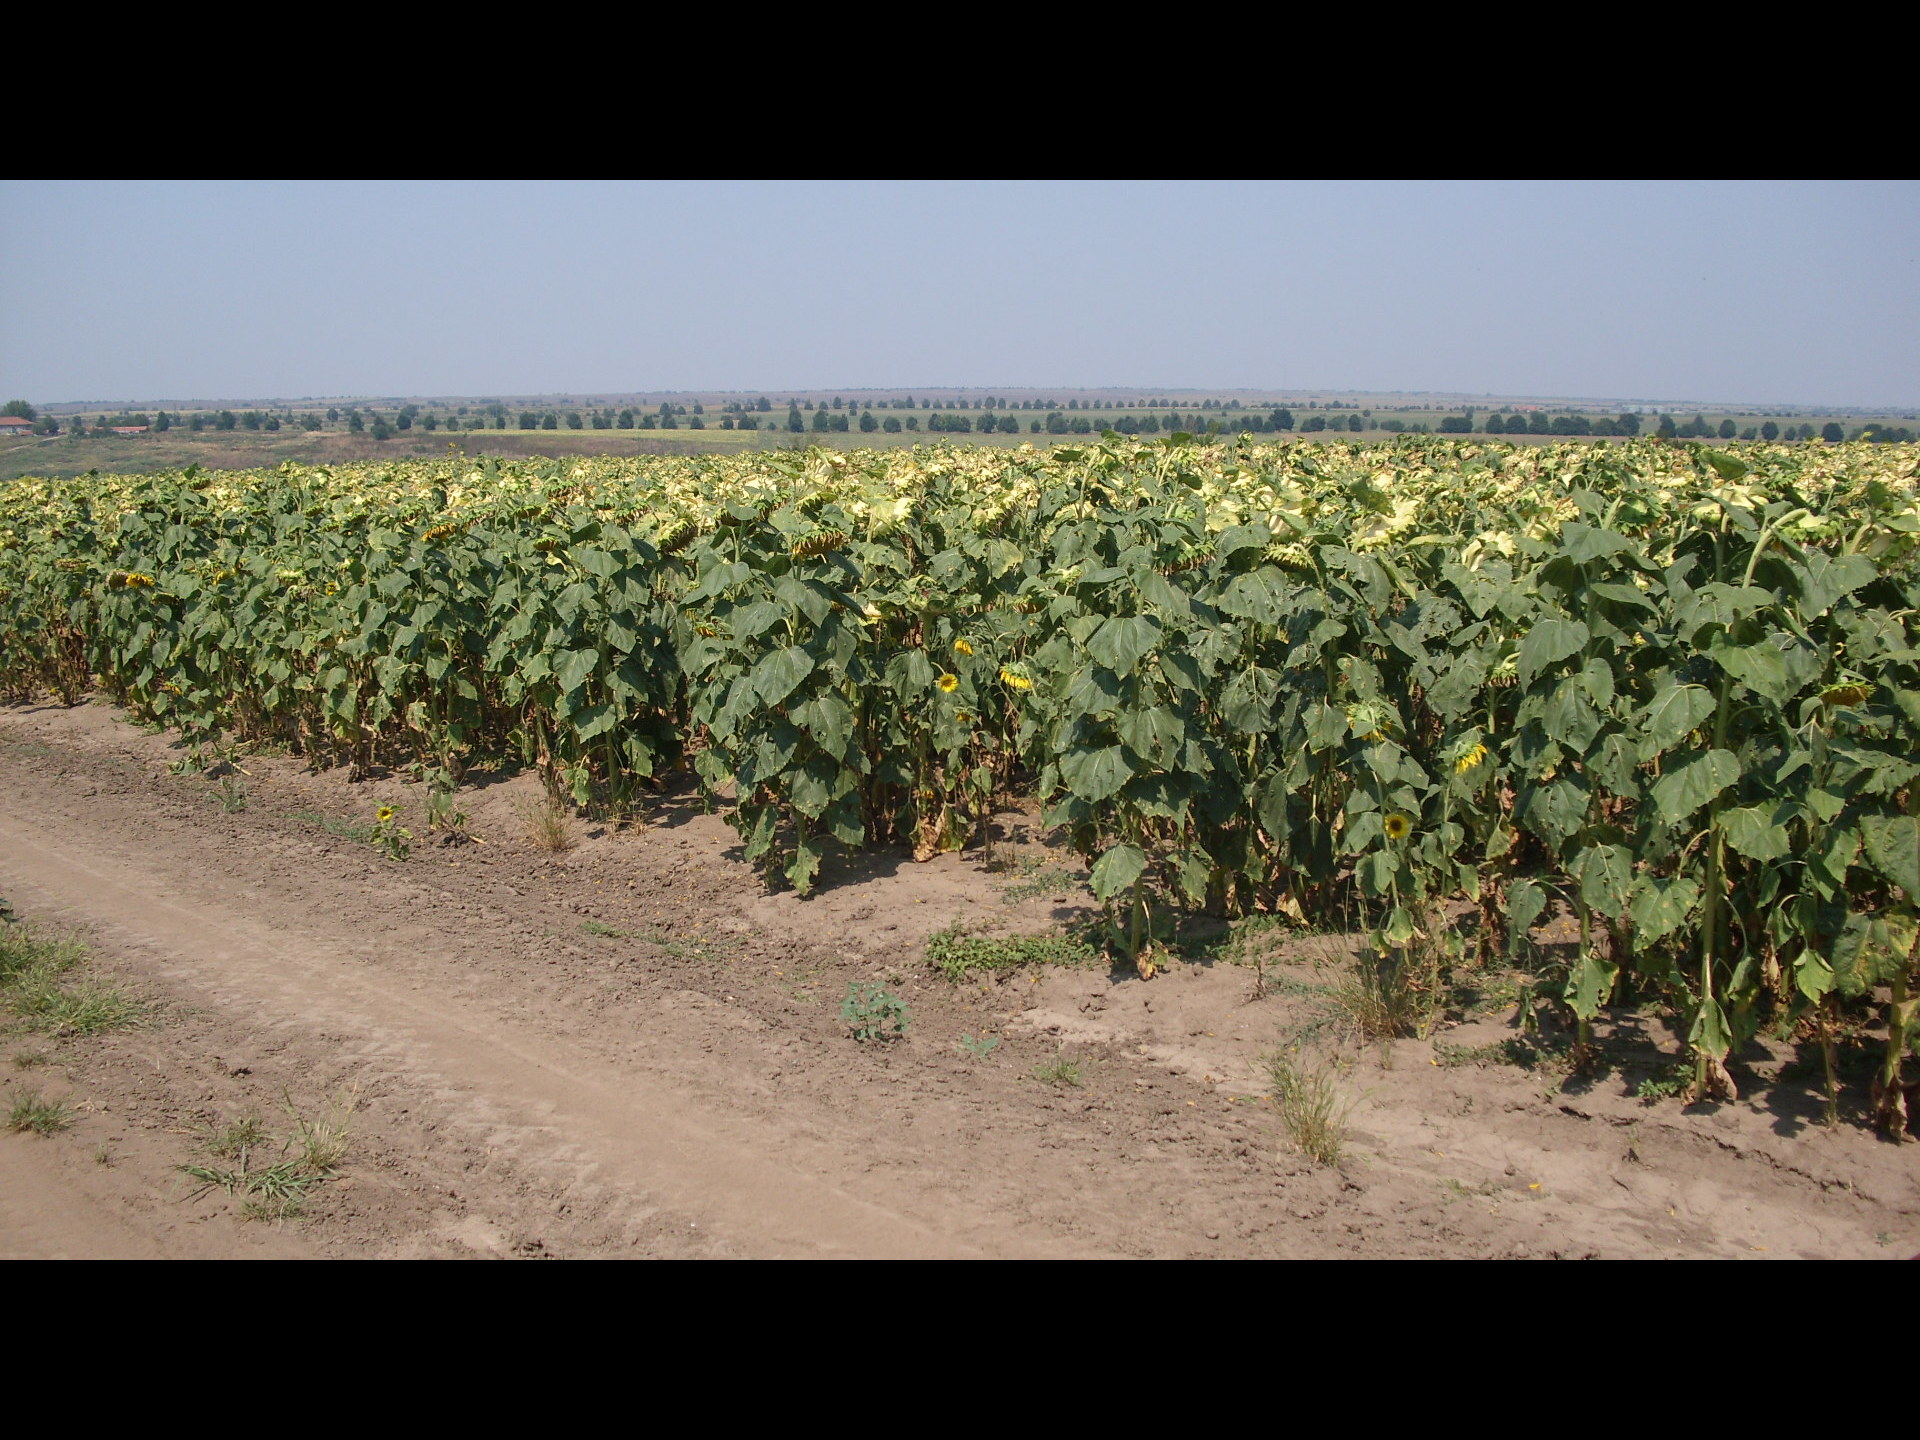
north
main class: Cropland
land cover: Maize
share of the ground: > 75 %
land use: Agriculture (excluding fallow land and kitchen gardens)
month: July
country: BG
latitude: 43.7901
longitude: 23.3797
